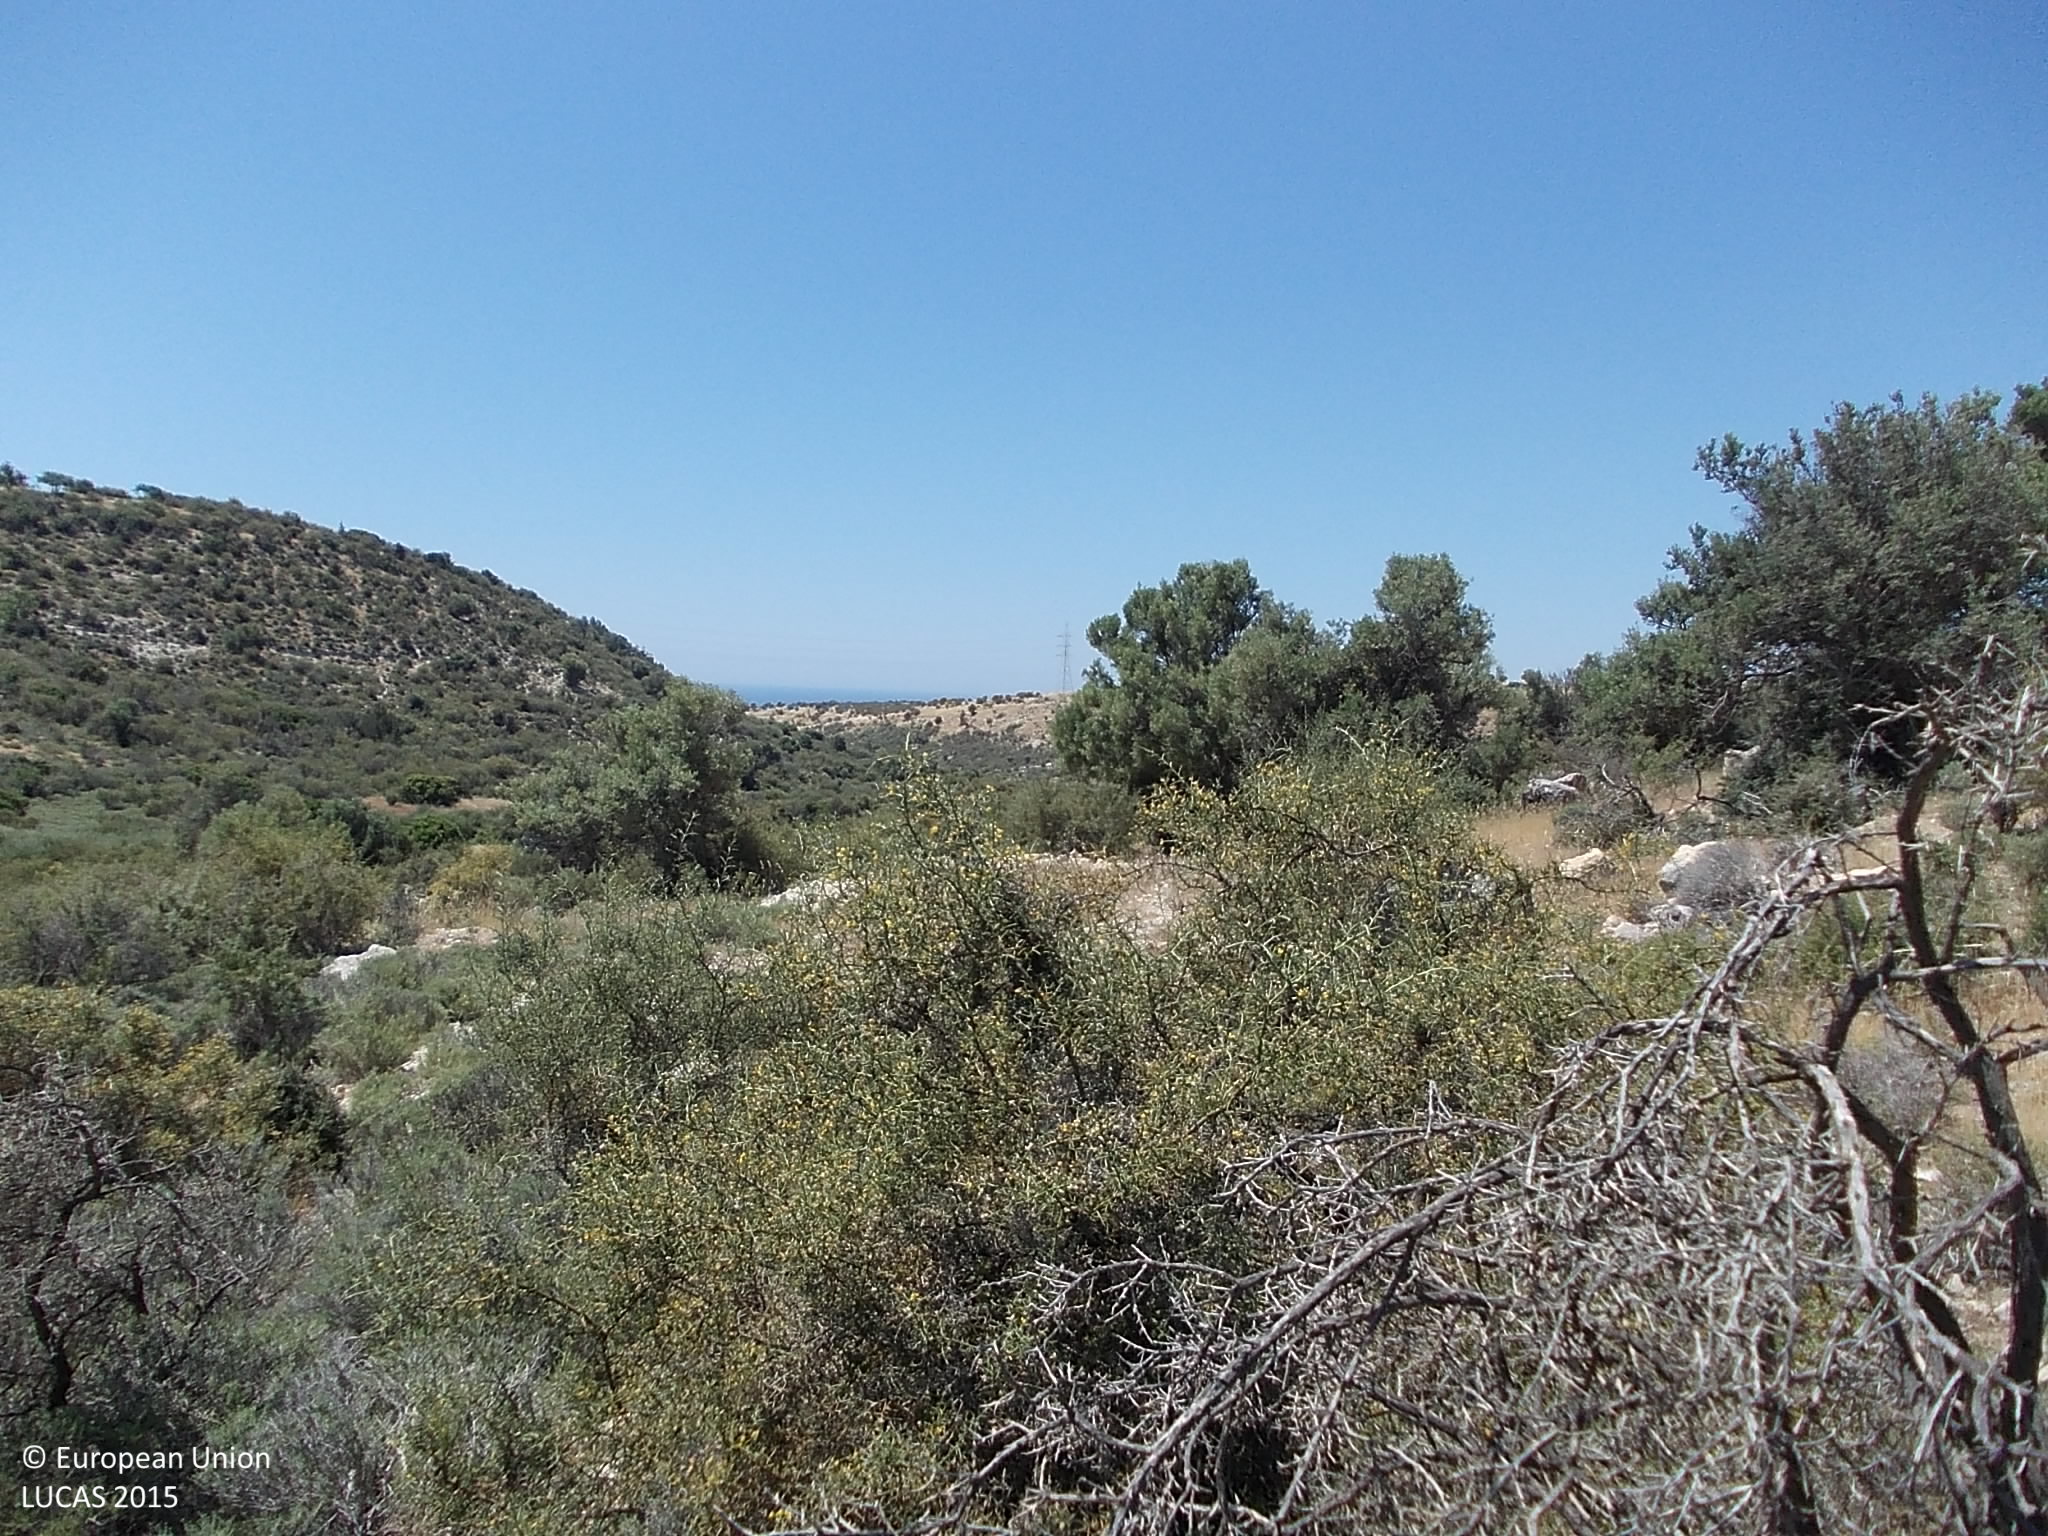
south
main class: Shrubland
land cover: Shrubland without tree cover
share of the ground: > 75 %
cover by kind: shrubs 80 %, unconsolidated bare surface 20 %
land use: Semi-natural and natural areas not in use
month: May
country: CY
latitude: 34.6984
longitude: 32.7862
